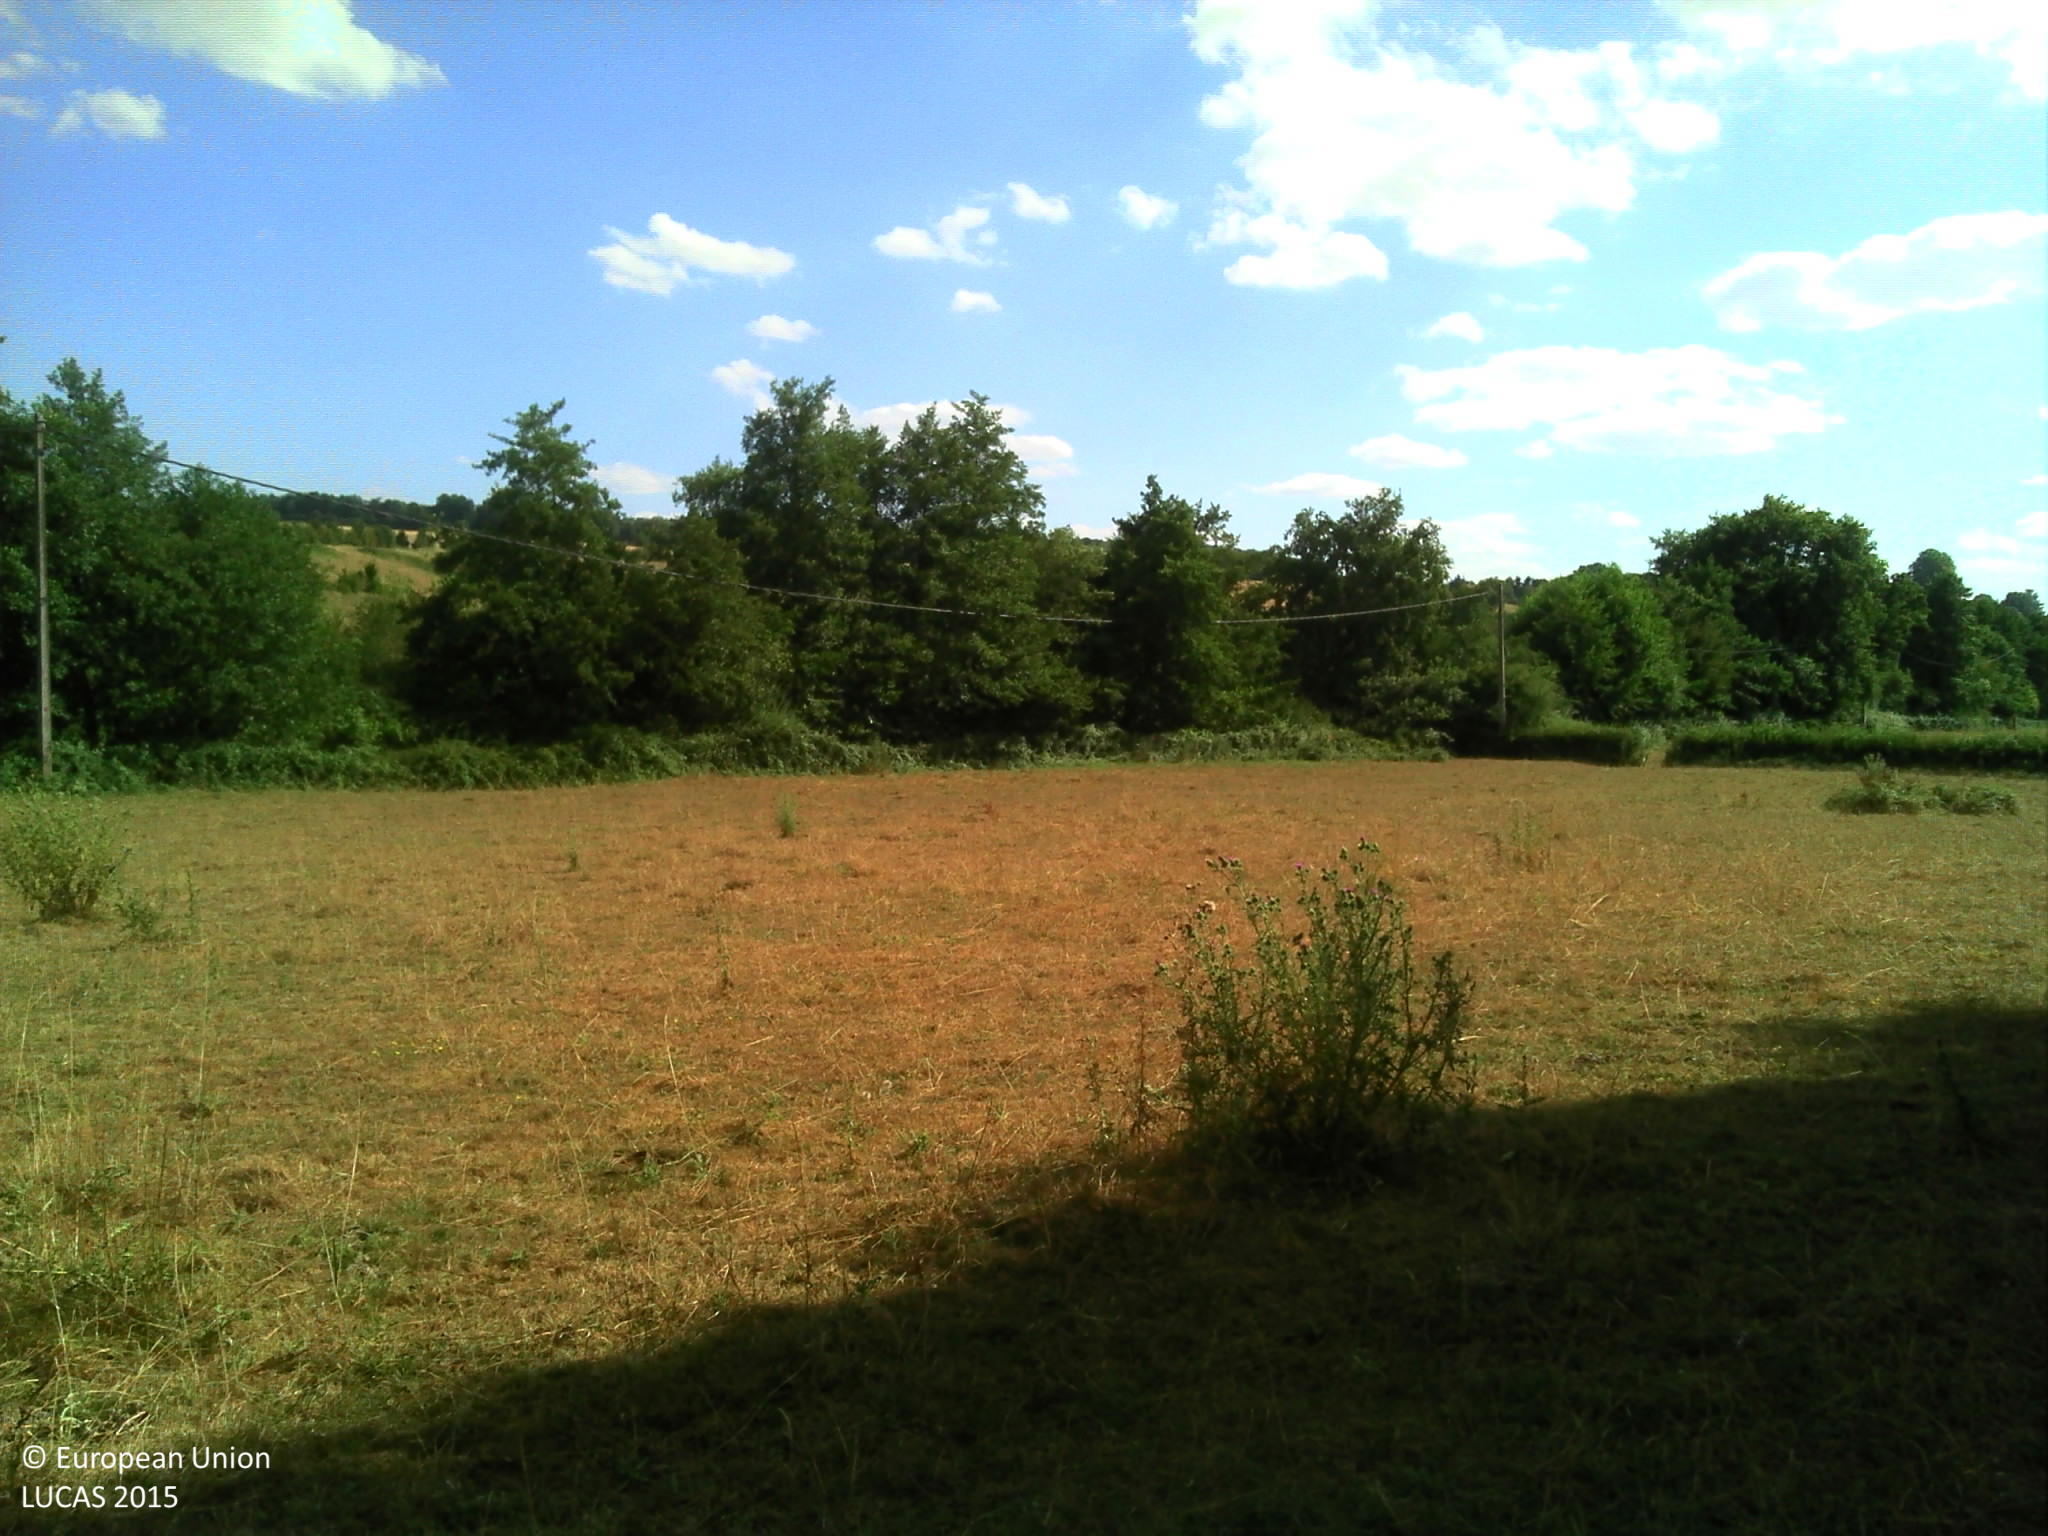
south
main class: Grassland
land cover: Grassland without tree/shrub cover
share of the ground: > 75 %
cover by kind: herbaceous plants 95 %, shrubs 5 %
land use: Agriculture (excluding fallow land and kitchen gardens)
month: July
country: FR
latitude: 46.4817
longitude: 2.9761
